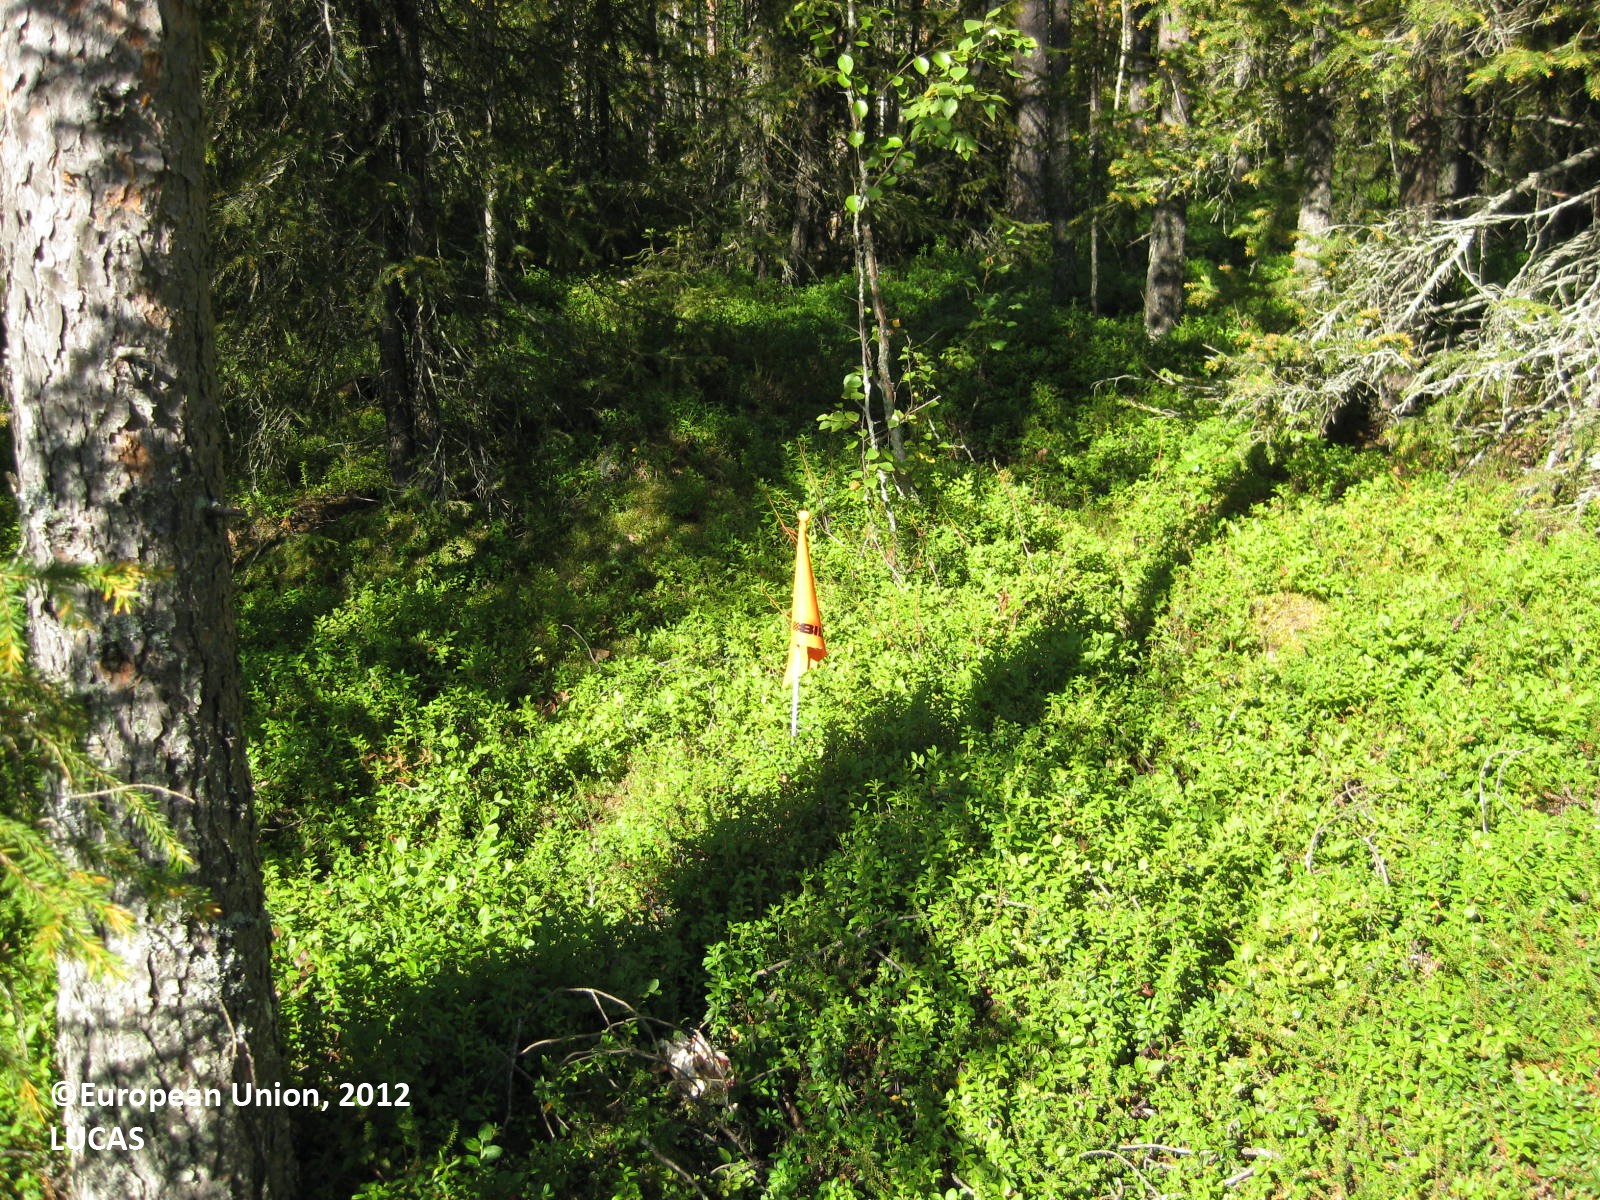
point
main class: Woodland
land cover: Other coniferous woodland
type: boreal forest
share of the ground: > 75 %
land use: Forestry
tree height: > 5 m
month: August
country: FI
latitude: 66.3557
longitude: 29.0489
